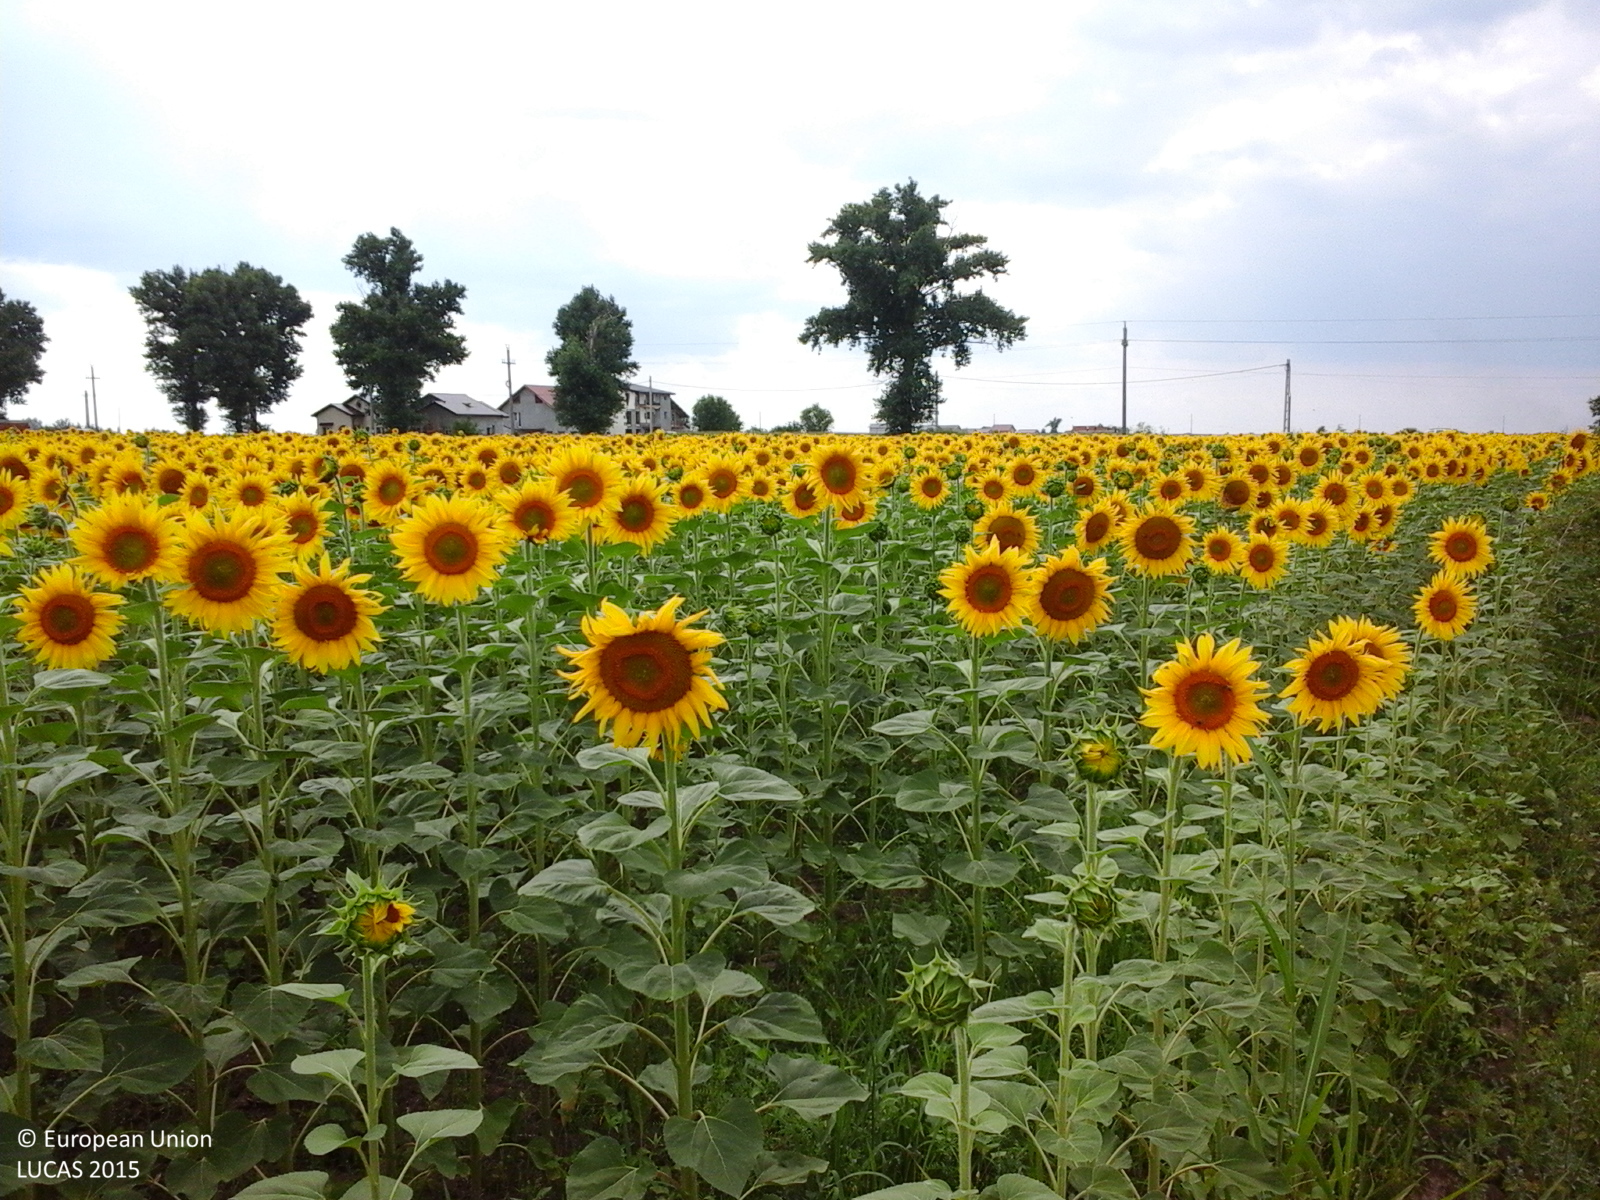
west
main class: Cropland
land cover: Sunflower
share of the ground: > 75 %
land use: Agriculture (excluding fallow land and kitchen gardens)
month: June
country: RO
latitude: 44.2824
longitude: 26.1821
